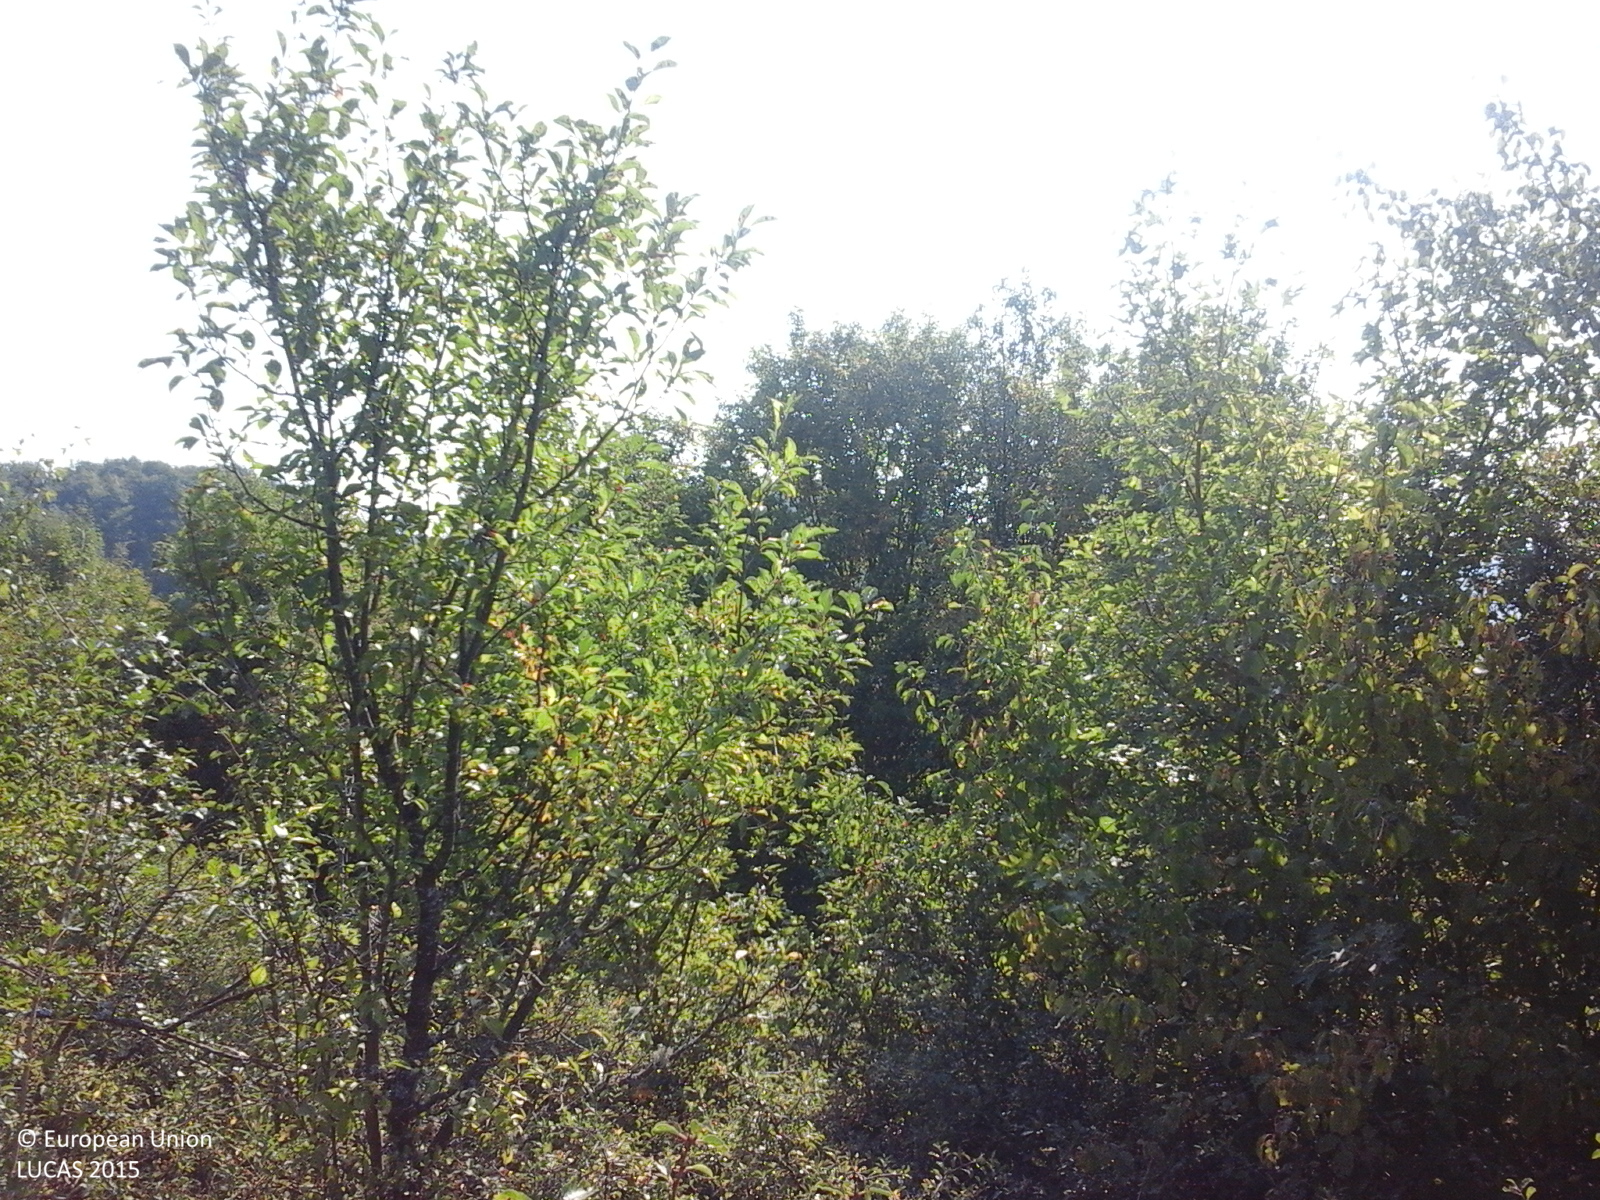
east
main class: Shrubland
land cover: Shrubland with sparse tree cover
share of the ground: > 75 %
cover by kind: shrubs 95 %, broadleaved forest trees 5 %
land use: Semi-natural and natural areas not in use
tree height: < 5 m
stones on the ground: < 10 %
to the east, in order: Shrubland with sparse tree cover; Grassland with sparse tree/shrub cover
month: September
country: RO
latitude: 47.0036
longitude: 24.4915
